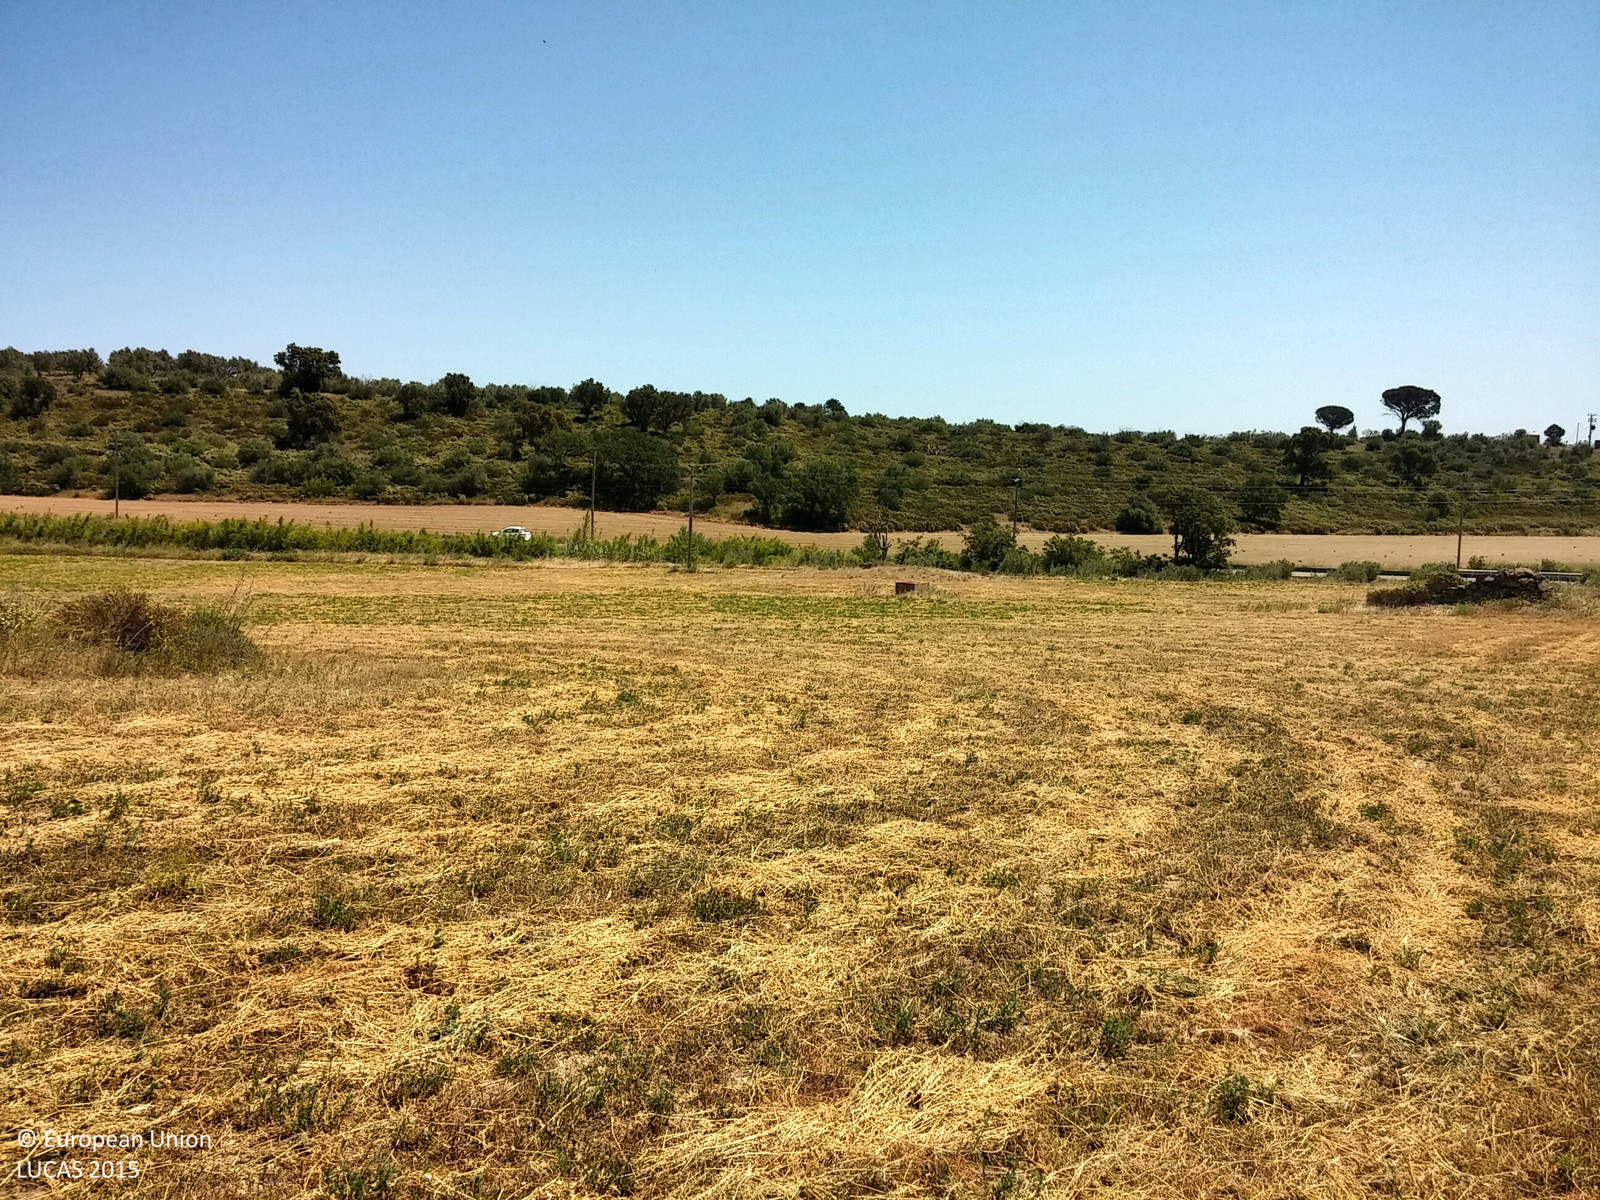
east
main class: Cropland
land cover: Lucerne
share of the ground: > 75 %
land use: Agriculture (excluding fallow land and kitchen gardens)
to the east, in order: Lucerne; Electric lines; Lucerne; Grassland without tree/shrub cover; Grassland with sparse tree/shrub cover; Grassland without tree/shrub cover; Paved roads, cycling and walking lanes; Grass margins; Electric lines; Temporary grasslands; Shrubland with sparse tree cover; Olive groves
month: May
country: ES
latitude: 42.3742
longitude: 2.9822
